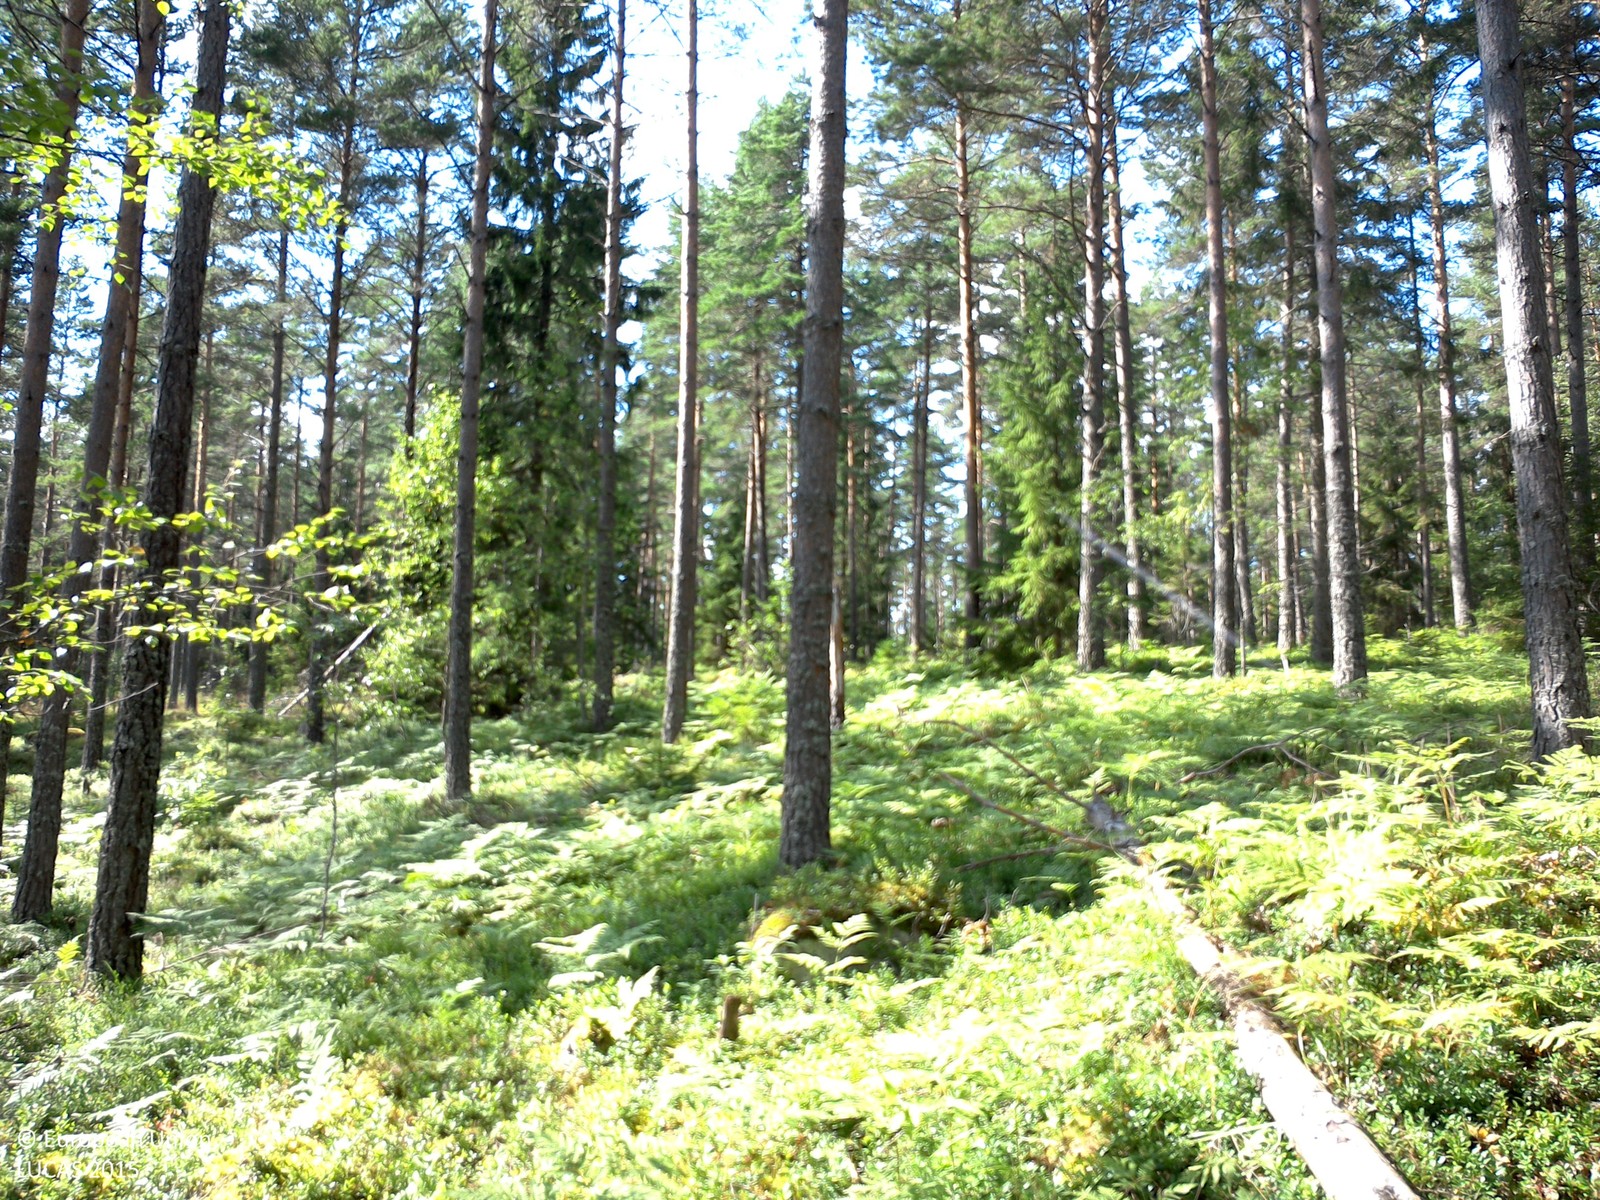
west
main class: Woodland
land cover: Pine dominated coniferous woodland
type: boreal forest
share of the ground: 25 - 50 %
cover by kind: herbaceous plants 65 %, coniferous forest trees 25 %, lichens and mosses 10 %
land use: Forestry
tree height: > 5 m
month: August
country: SE
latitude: 58.1645
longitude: 15.4171
